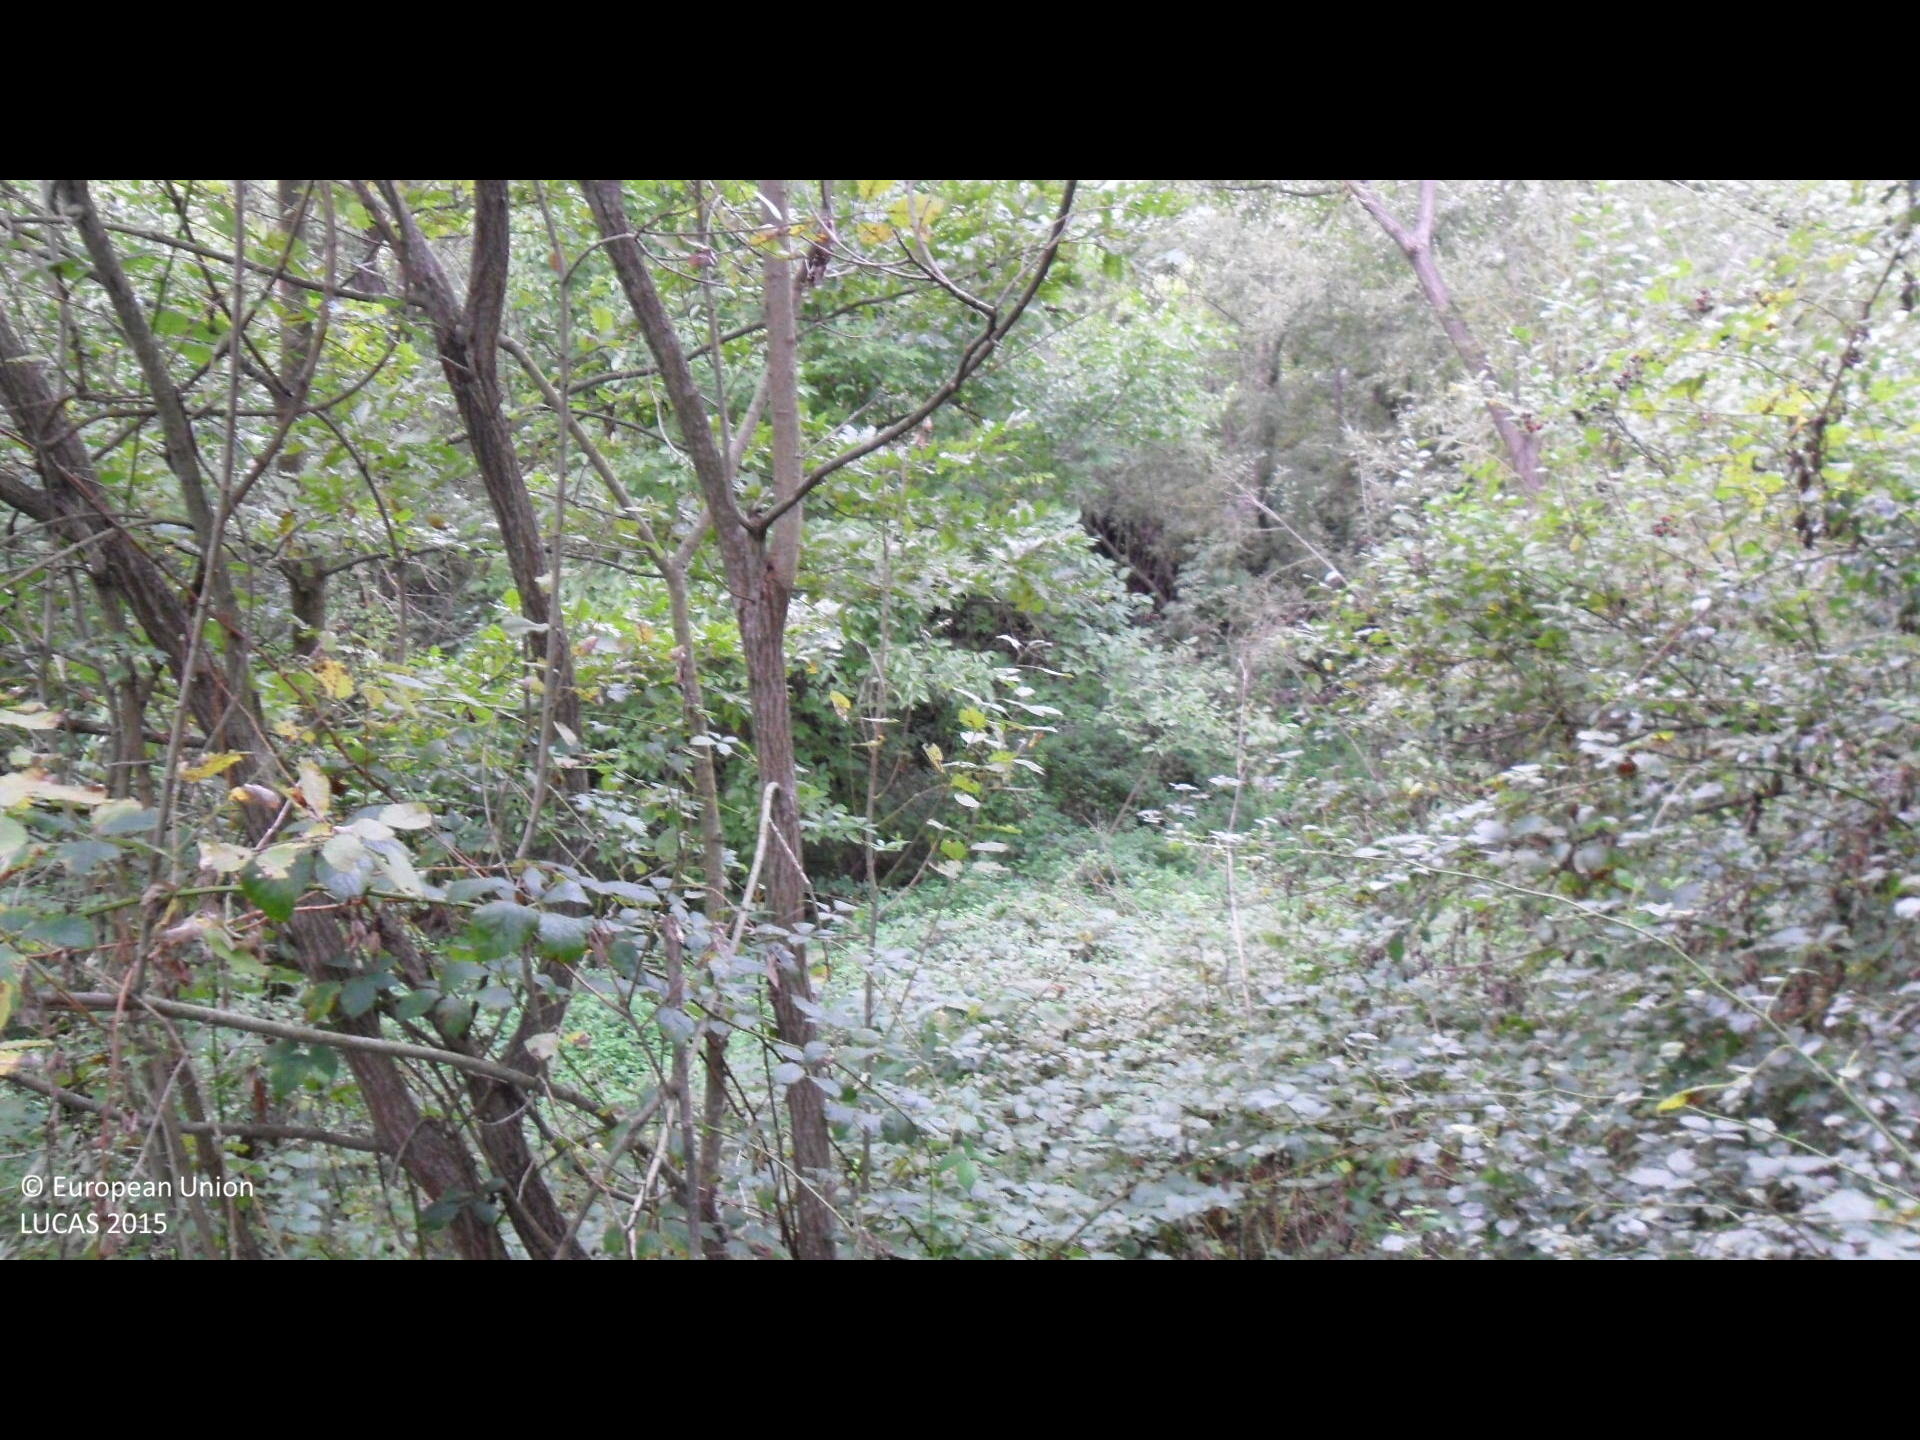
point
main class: Woodland
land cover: Broadleaved woodland
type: mesophytic deciduous forest
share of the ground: > 75 %
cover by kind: broadleaved forest trees 90 %, shrubs 5 %, unconsolidated bare surface 5 %
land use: Semi-natural and natural areas not in use
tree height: < 5 m
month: October
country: BG
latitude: 43.1467
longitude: 26.1633
